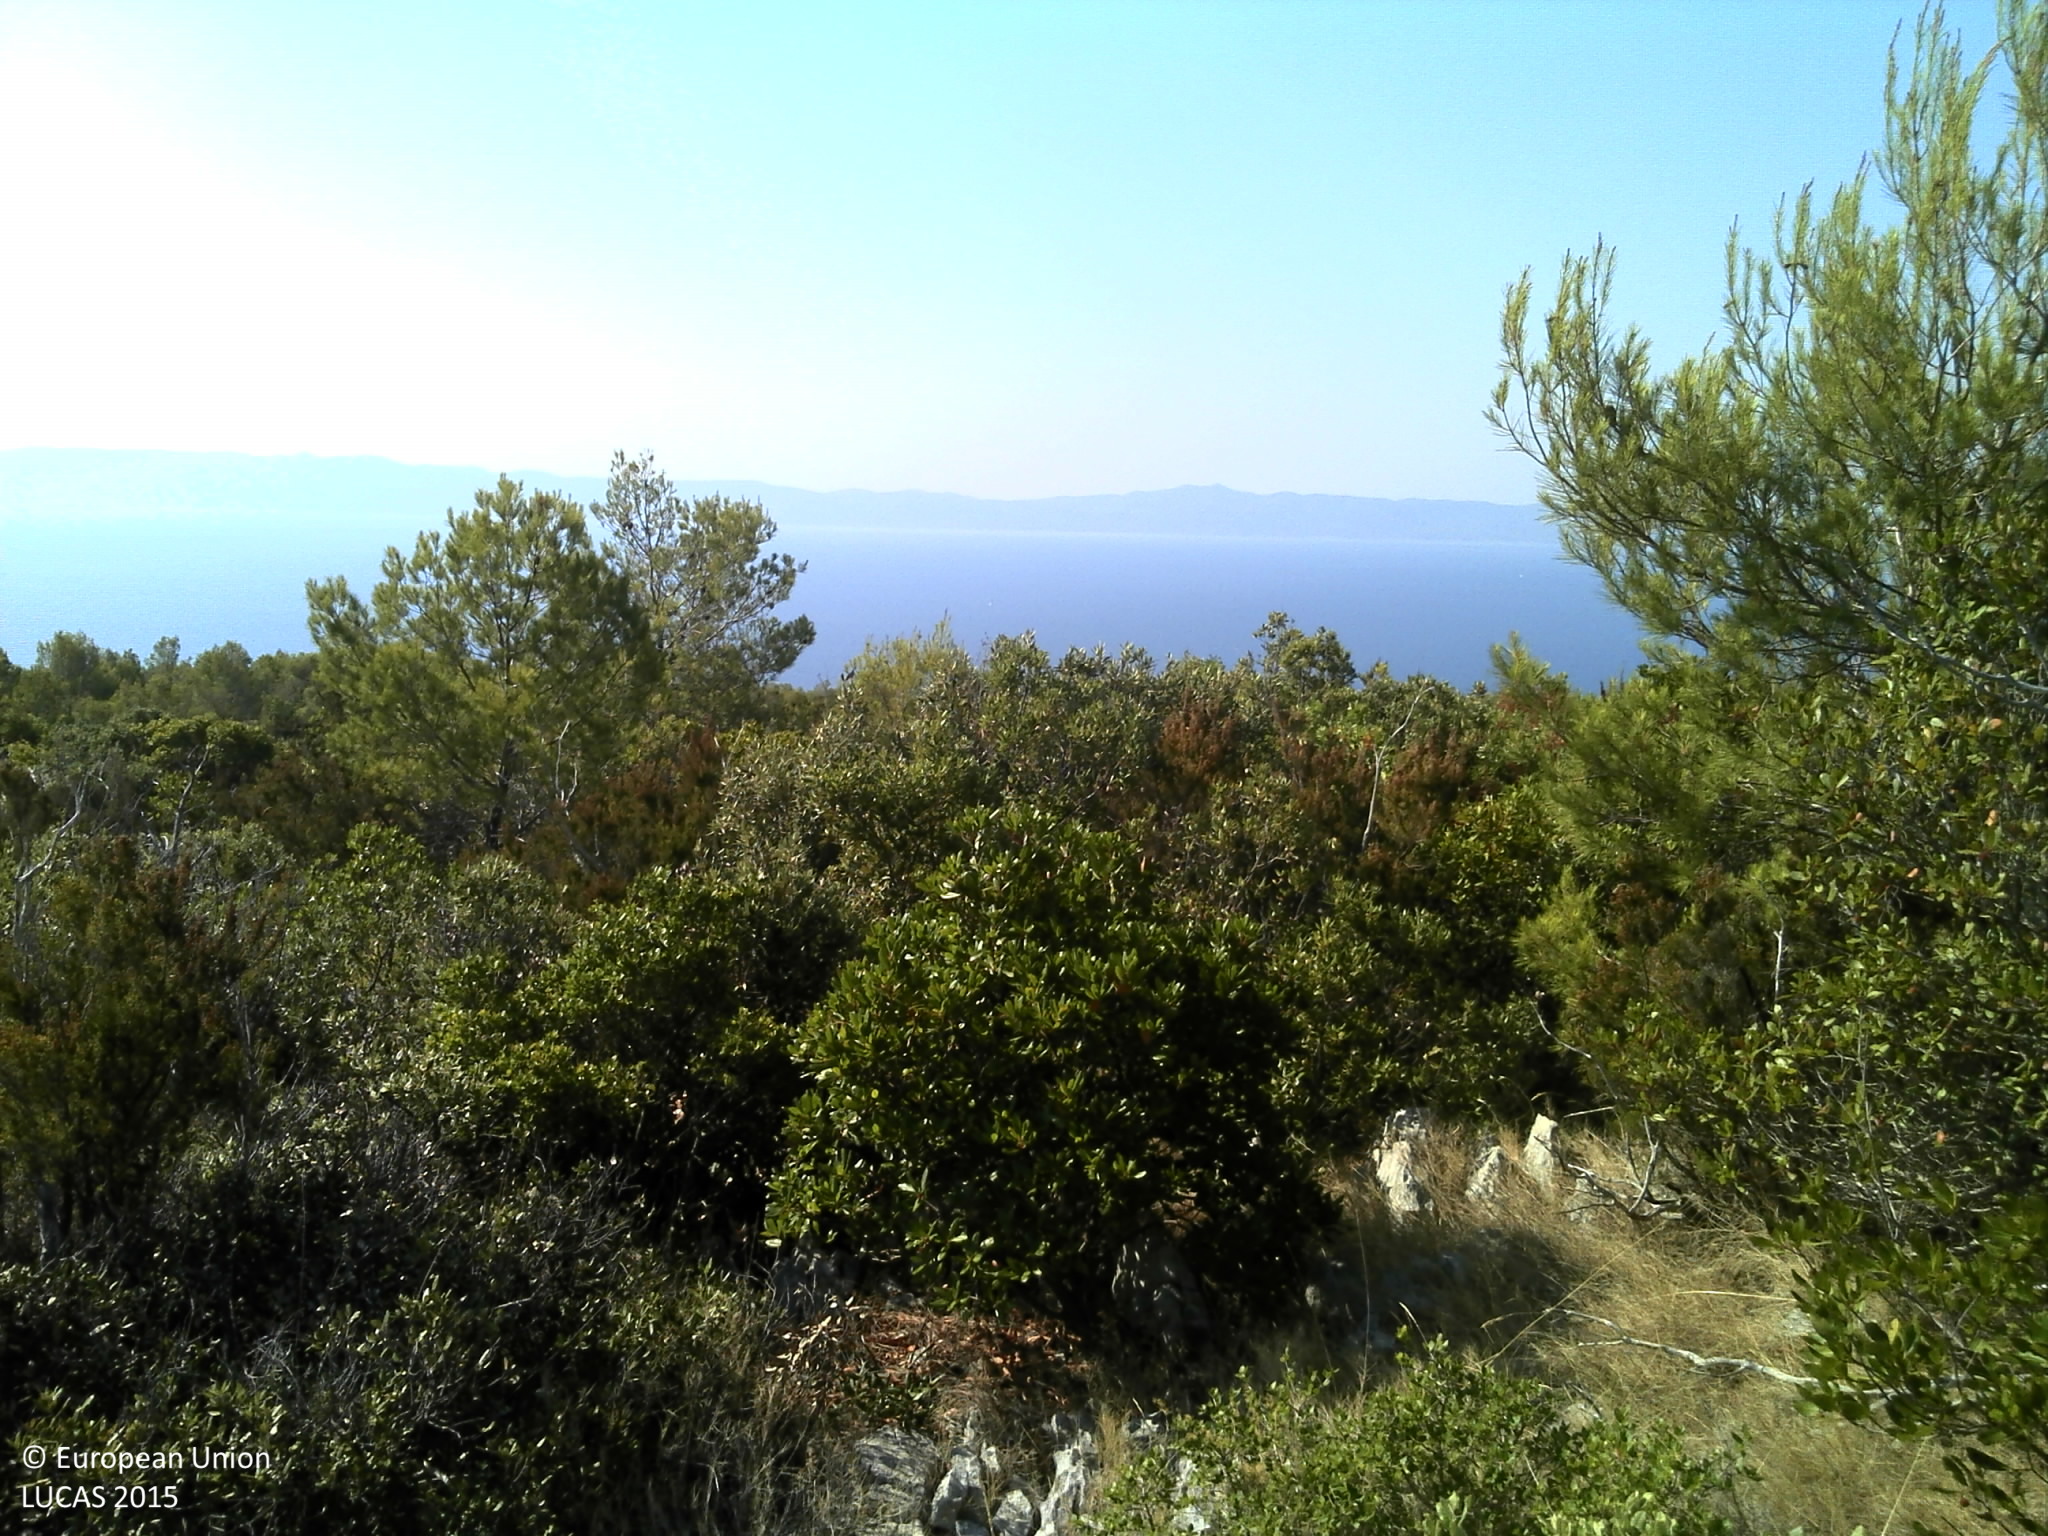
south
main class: Shrubland
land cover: Shrubland with sparse tree cover
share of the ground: > 75 %
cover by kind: shrubs 75 %, herbaceous plants 10 %, broadleaved forest trees 5 %, consolidated bare surface 5 %, unconsolidated bare surface 5 %
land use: Semi-natural and natural areas not in use
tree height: < 5 m
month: August
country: HR
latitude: 43.1277
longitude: 16.8611
